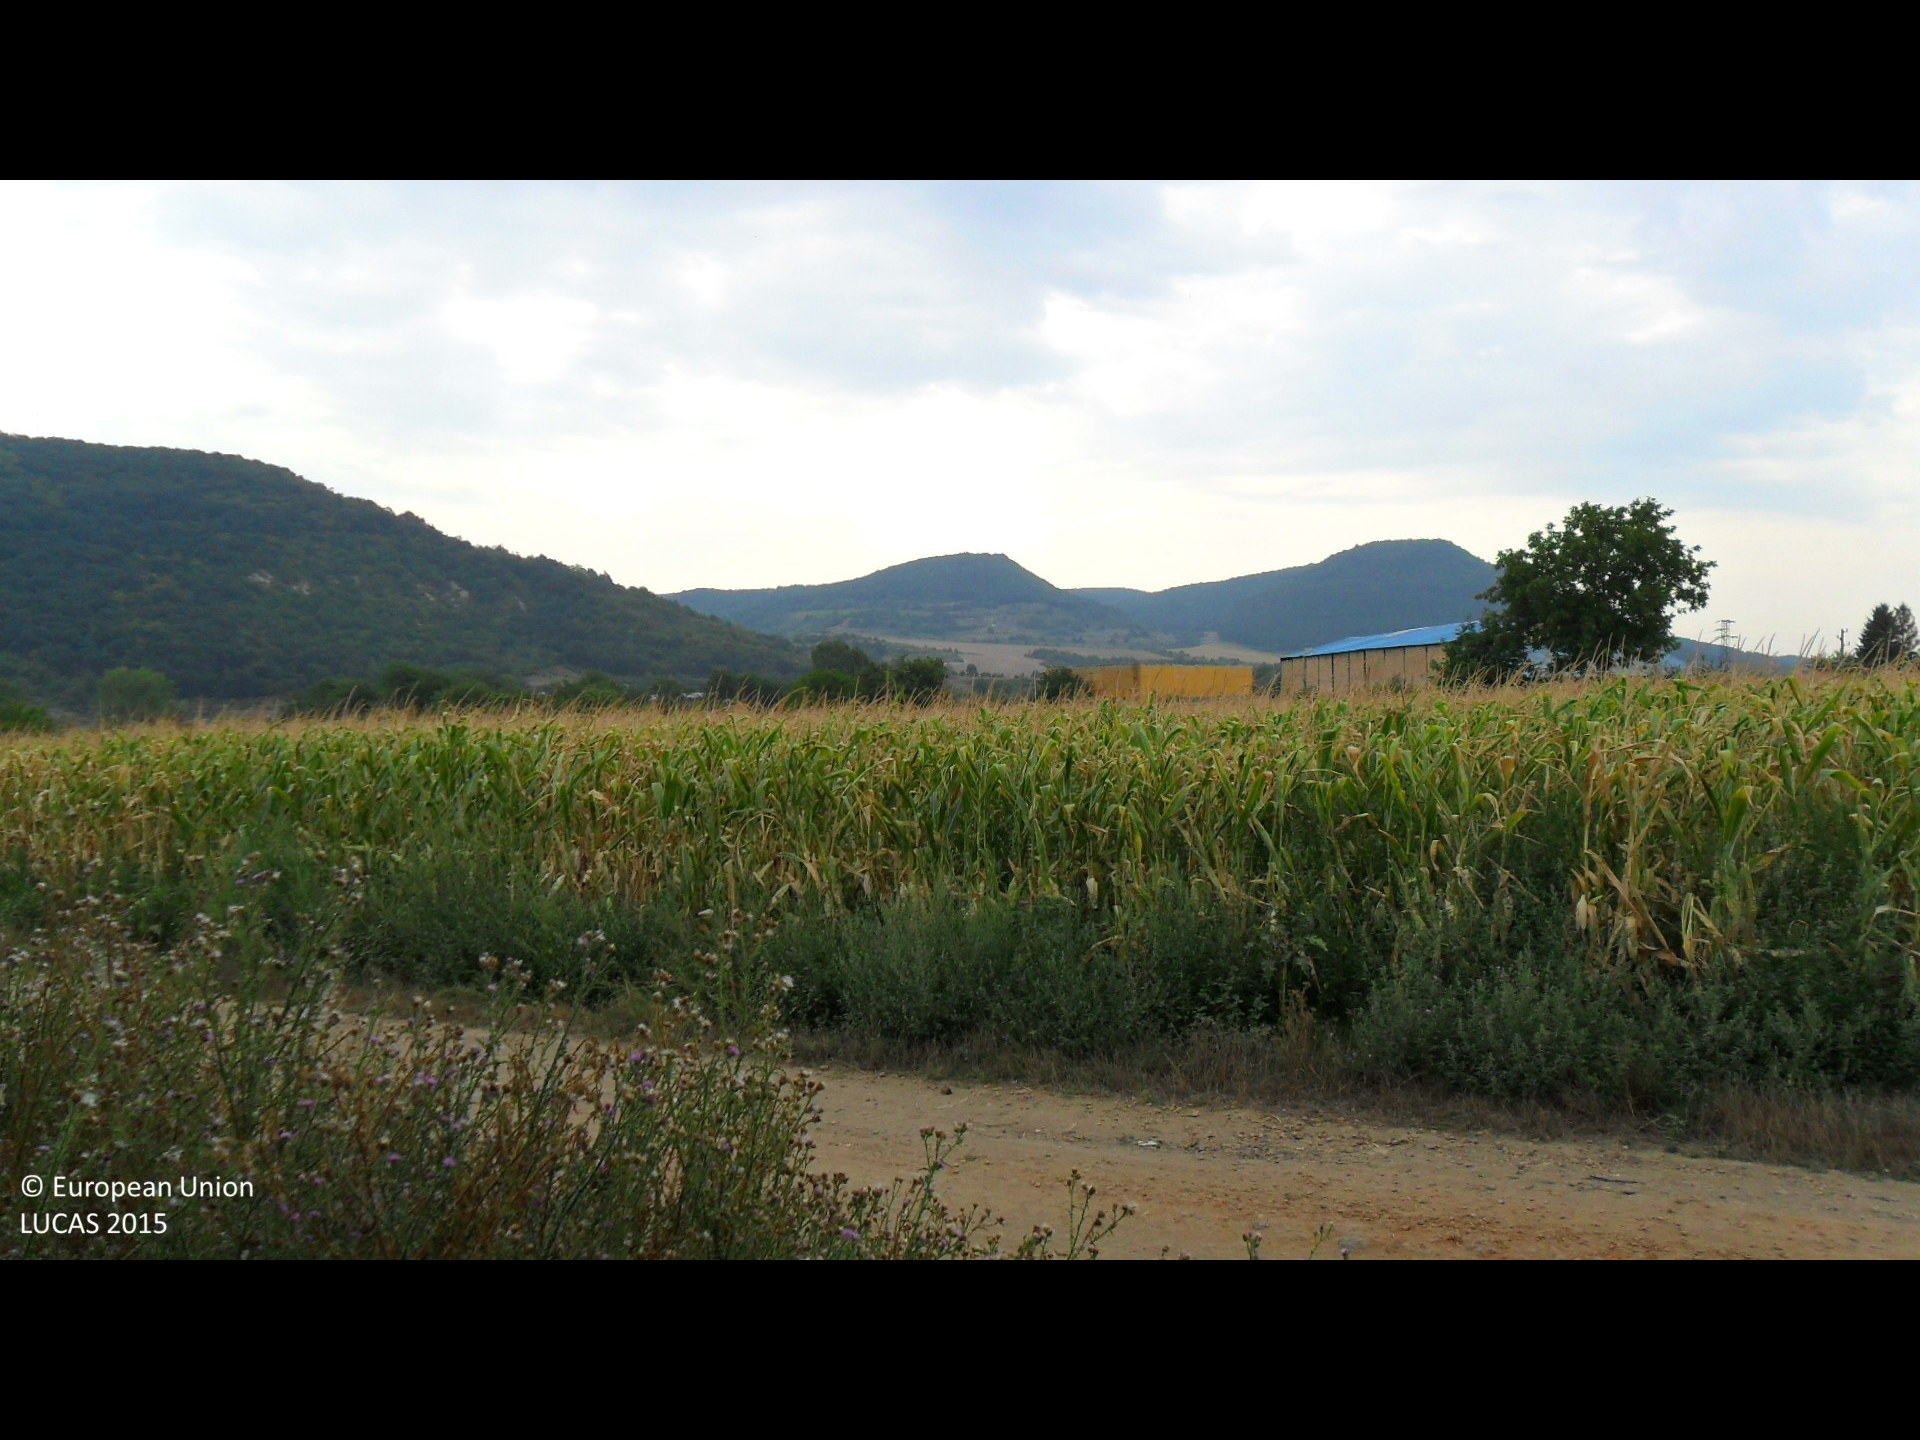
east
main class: Shrubland
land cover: Shrubland with sparse tree cover
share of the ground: > 75 %
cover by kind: shrubs 95 %, broadleaved forest trees 5 %
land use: Semi-natural and natural areas not in use
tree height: < 5 m
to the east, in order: Shrubland with sparse tree cover; Tracks; Maize; Shruby margins; Maize; Shrubland with sparse tree cover
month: August
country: BG
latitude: 43.4571
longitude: 26.1750
